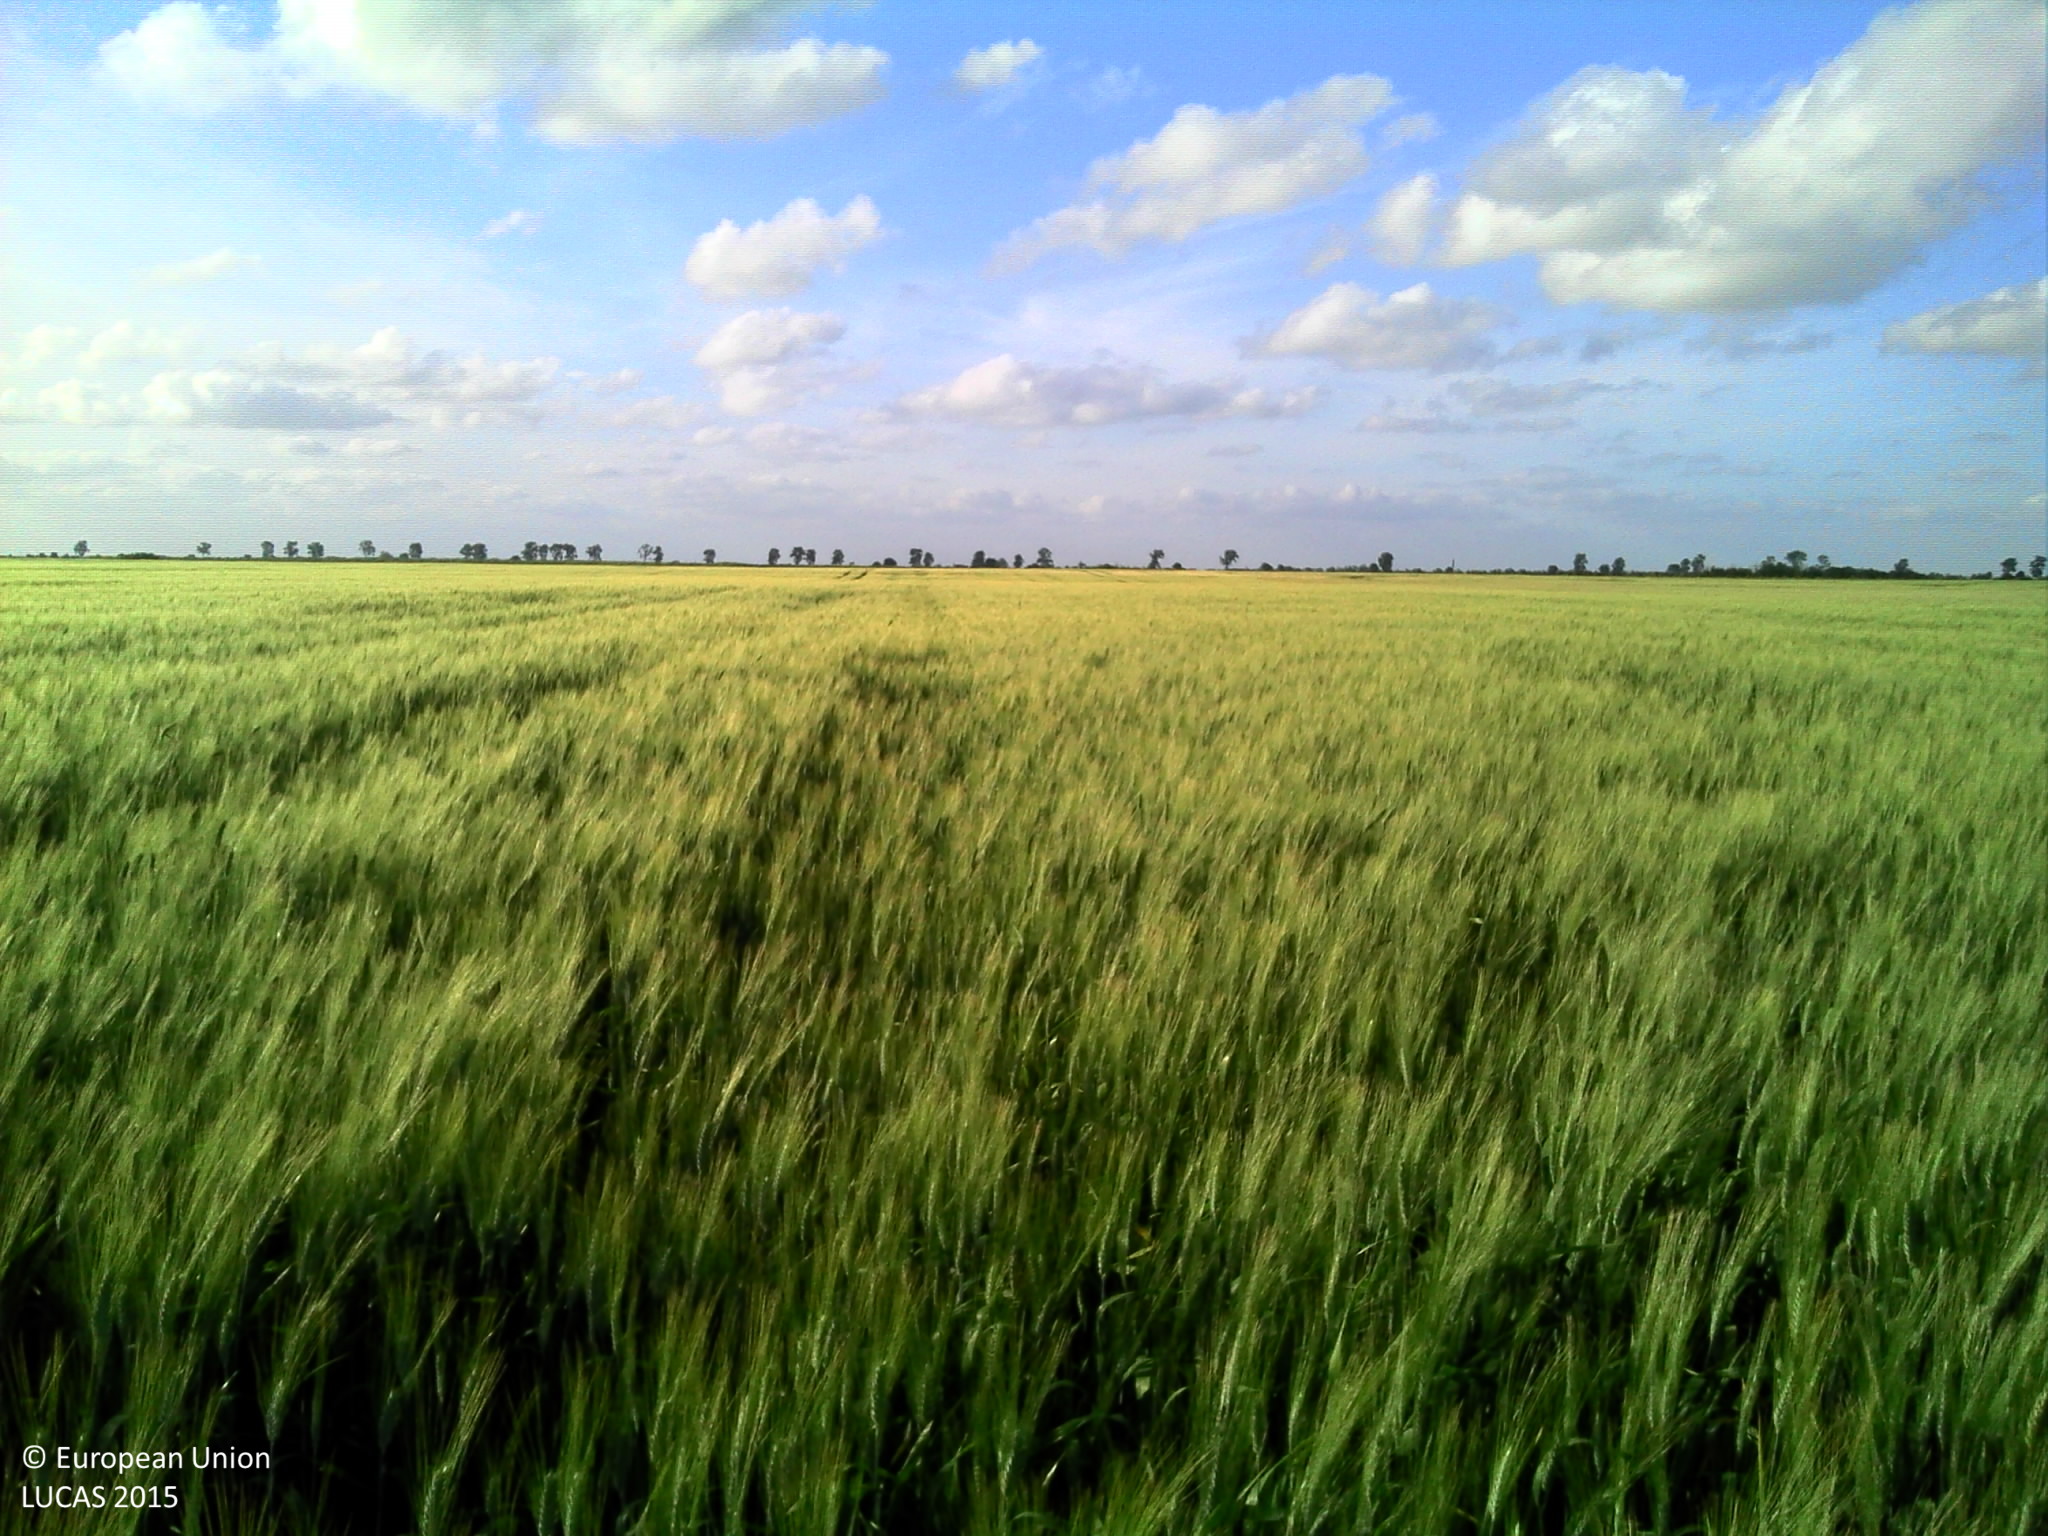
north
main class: Cropland
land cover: Common wheat
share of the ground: > 75 %
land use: Agriculture (excluding fallow land and kitchen gardens)
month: June
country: FR
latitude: 46.3033
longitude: -1.0545
